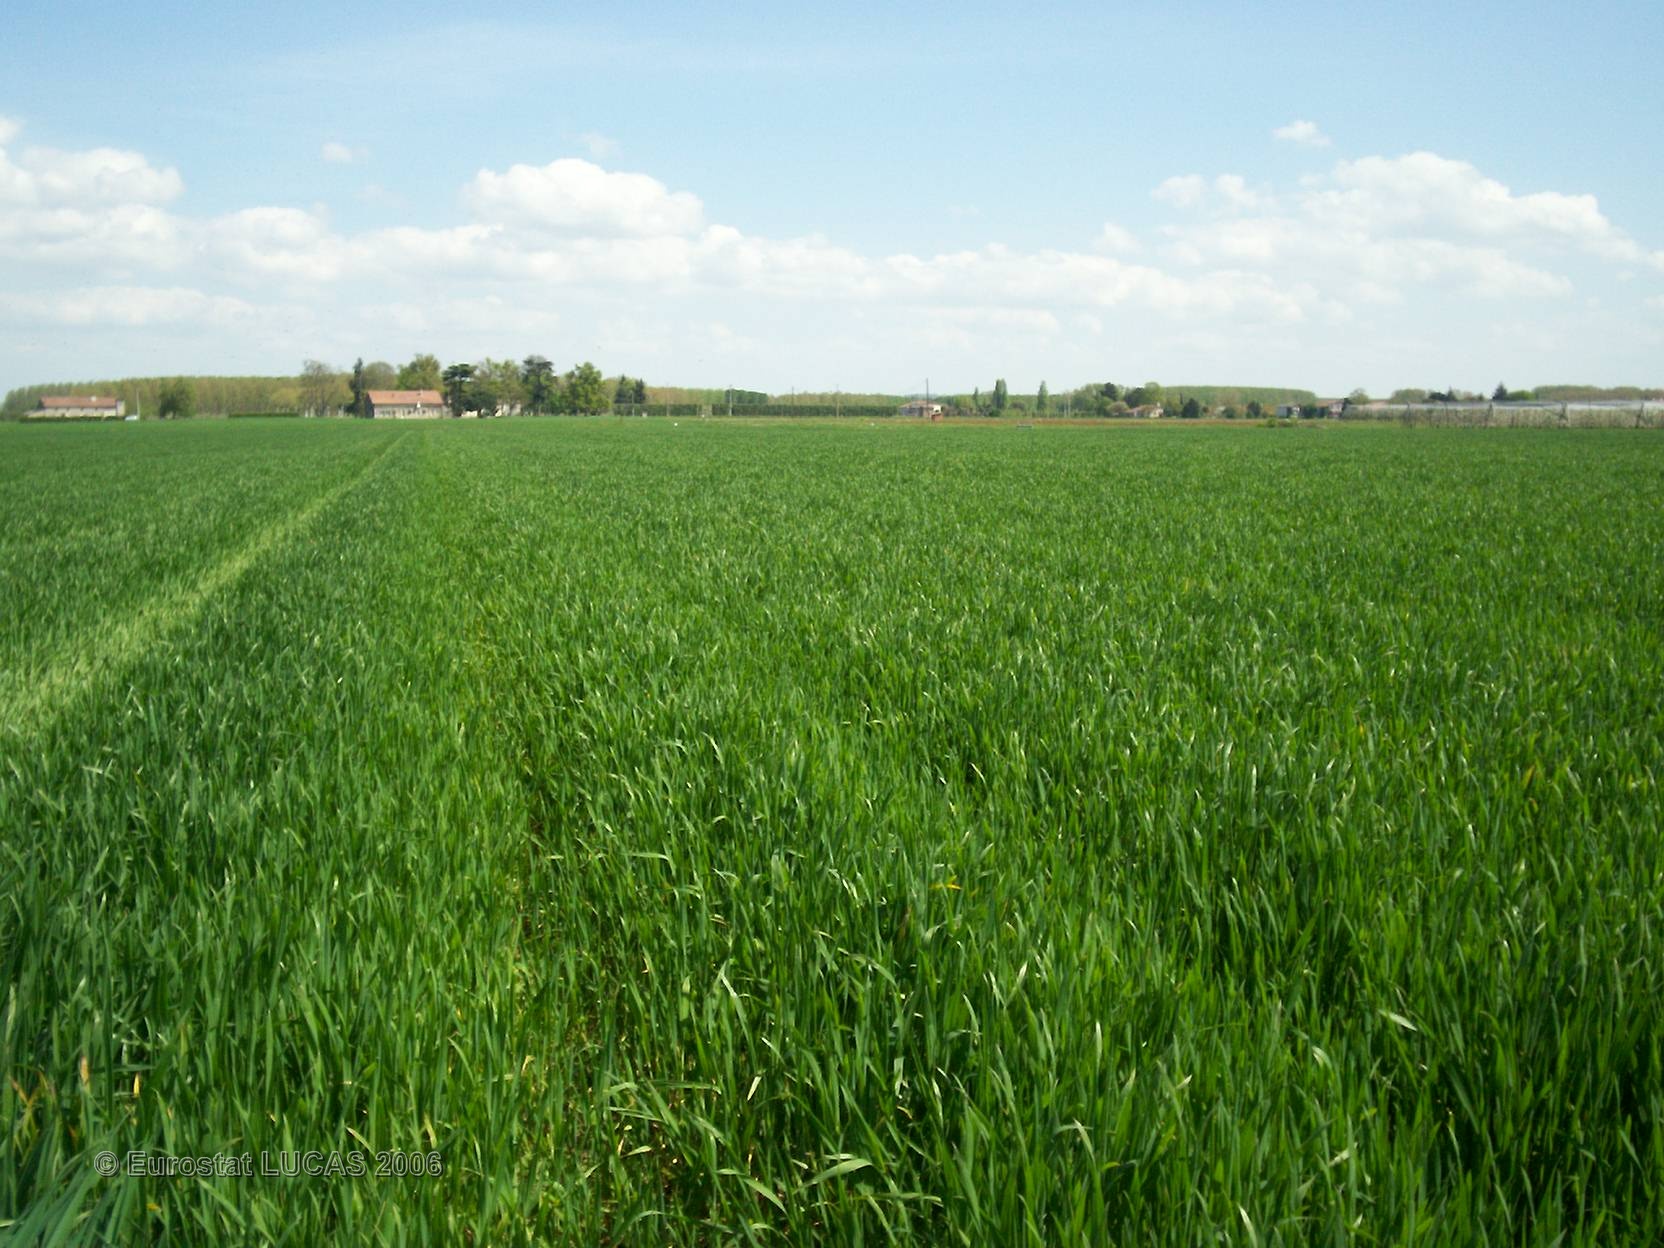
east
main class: Cropland
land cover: Common wheat
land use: Agriculture (excluding fallow land and kitchen gardens)
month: April
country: FR
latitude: 44.4927
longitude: 0.0924
